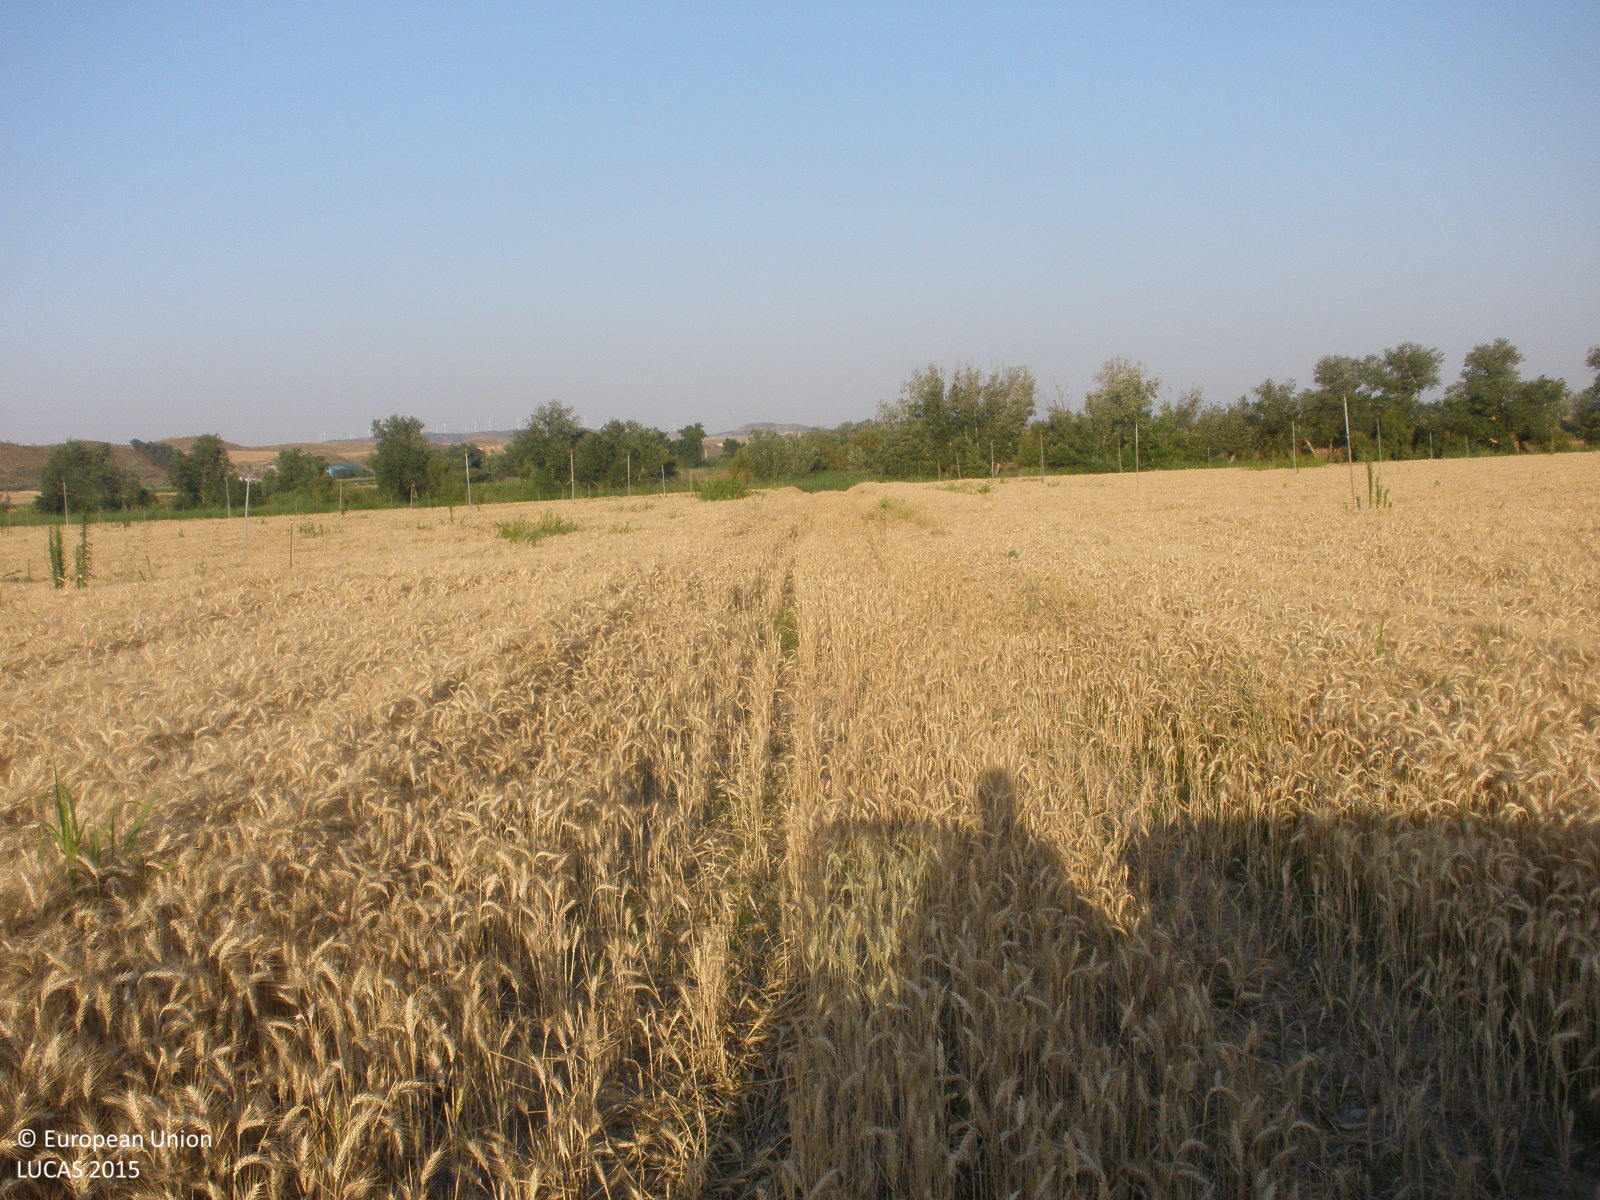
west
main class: Cropland
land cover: Common wheat
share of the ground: > 75 %
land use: Agriculture (excluding fallow land and kitchen gardens)
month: June
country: ES
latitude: 40.0582
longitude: -3.2629
